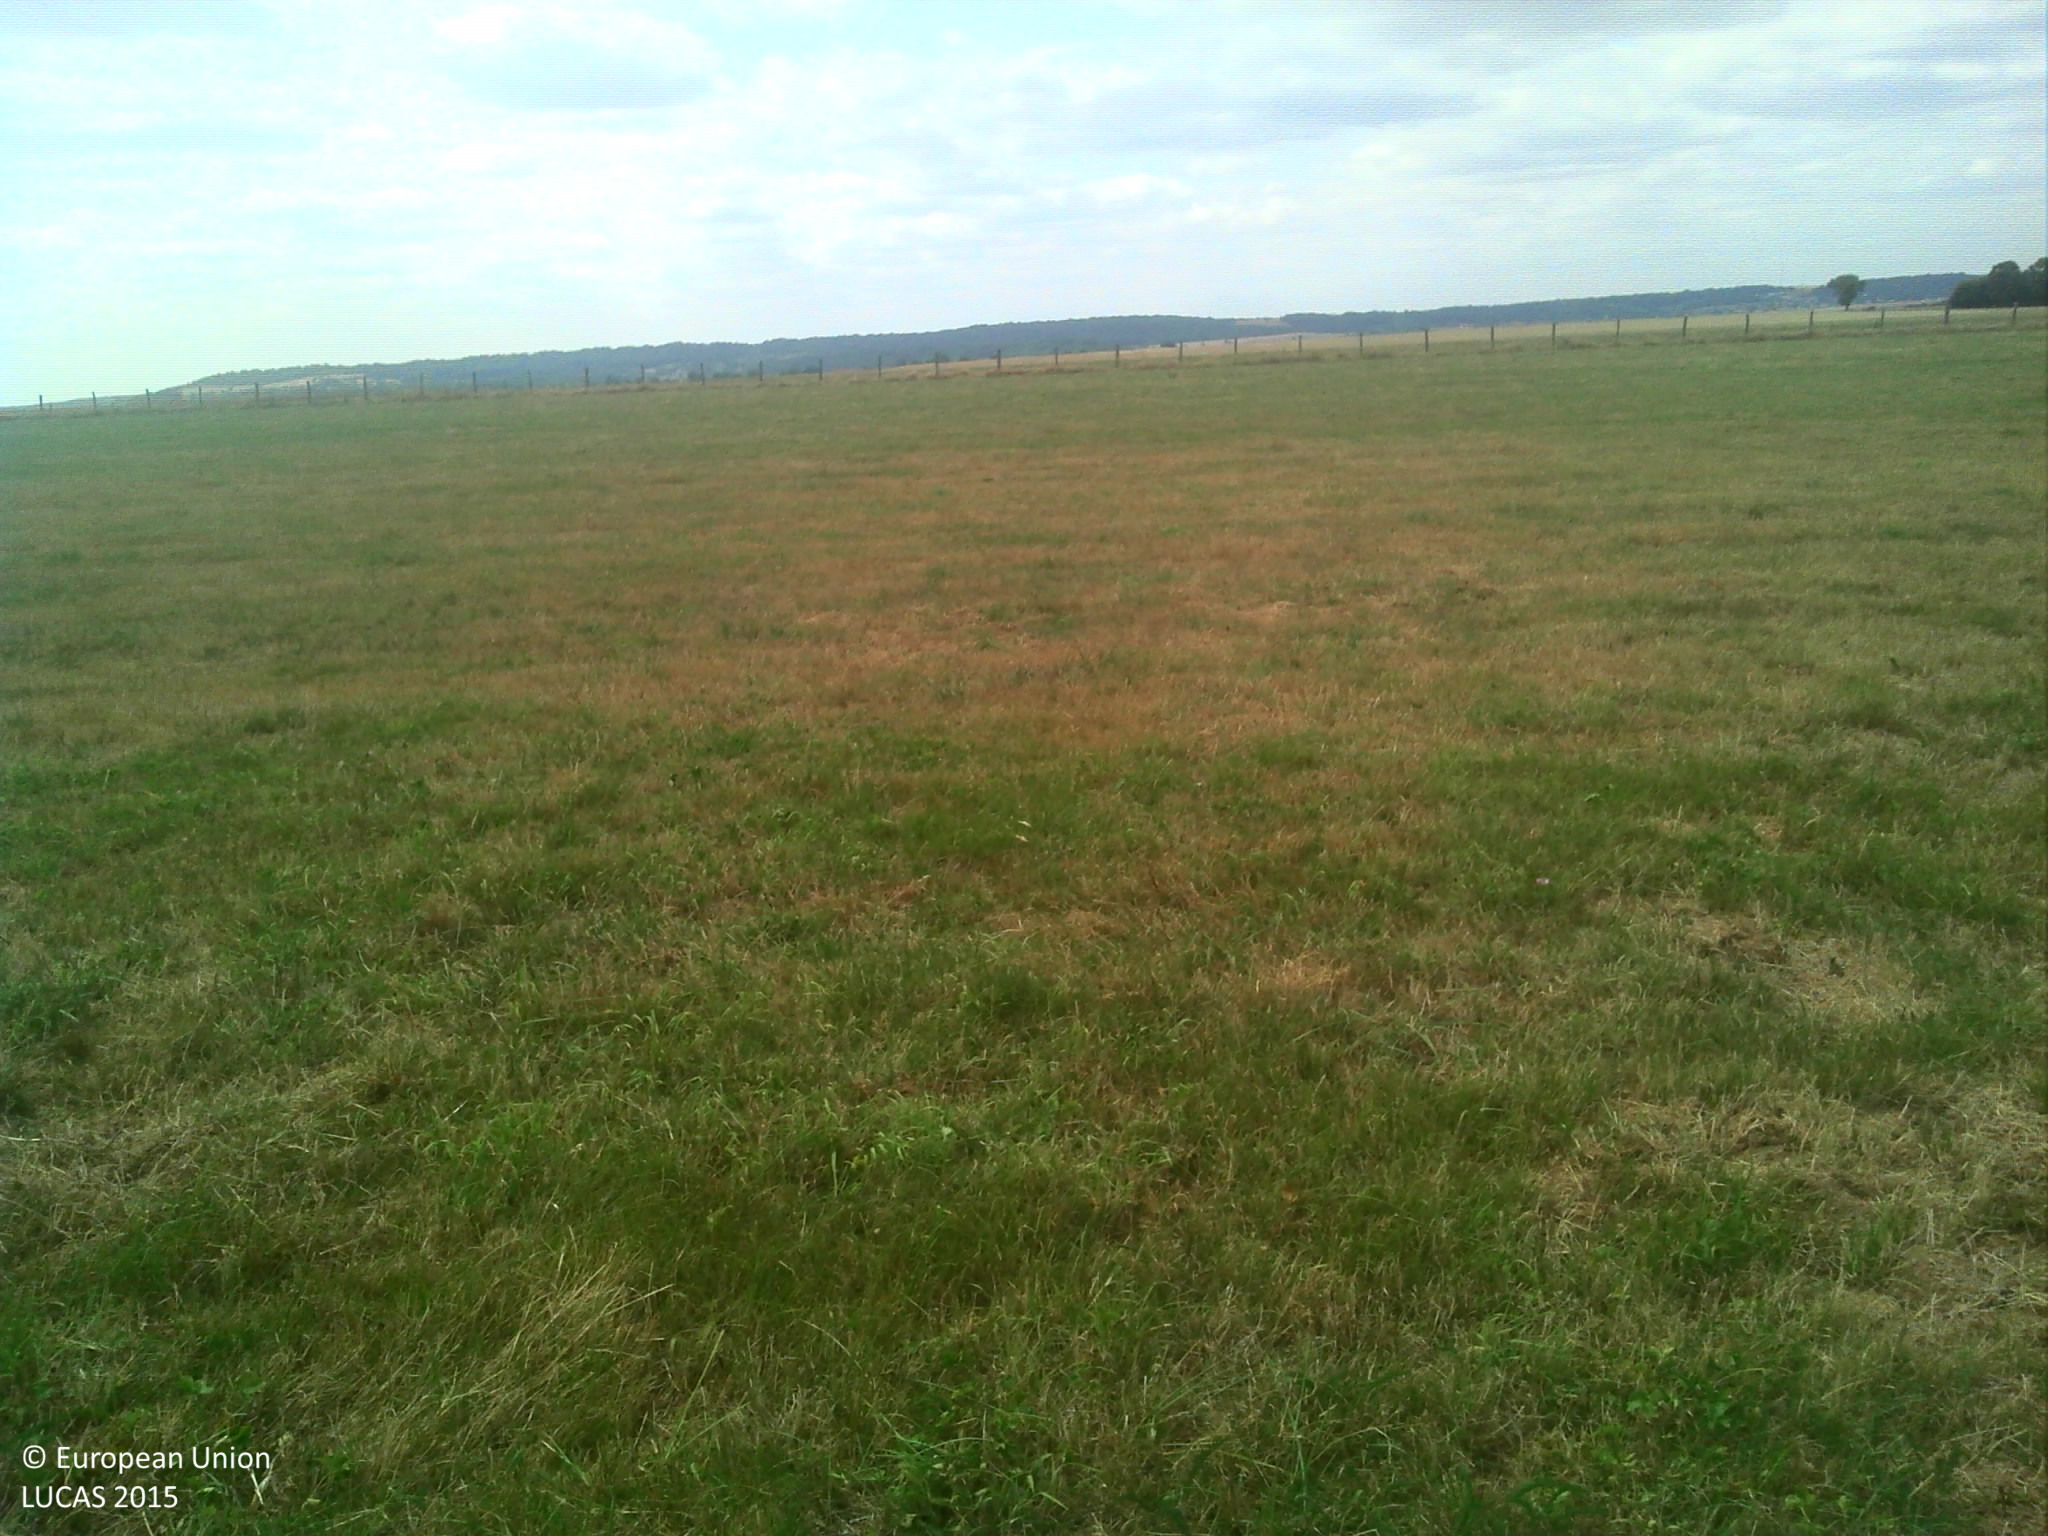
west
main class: Grassland
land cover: Grassland without tree/shrub cover
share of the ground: > 75 %
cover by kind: herbaceous plants 100 %
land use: Agriculture (excluding fallow land and kitchen gardens)
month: July
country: FR
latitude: 48.0965
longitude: 5.0981
